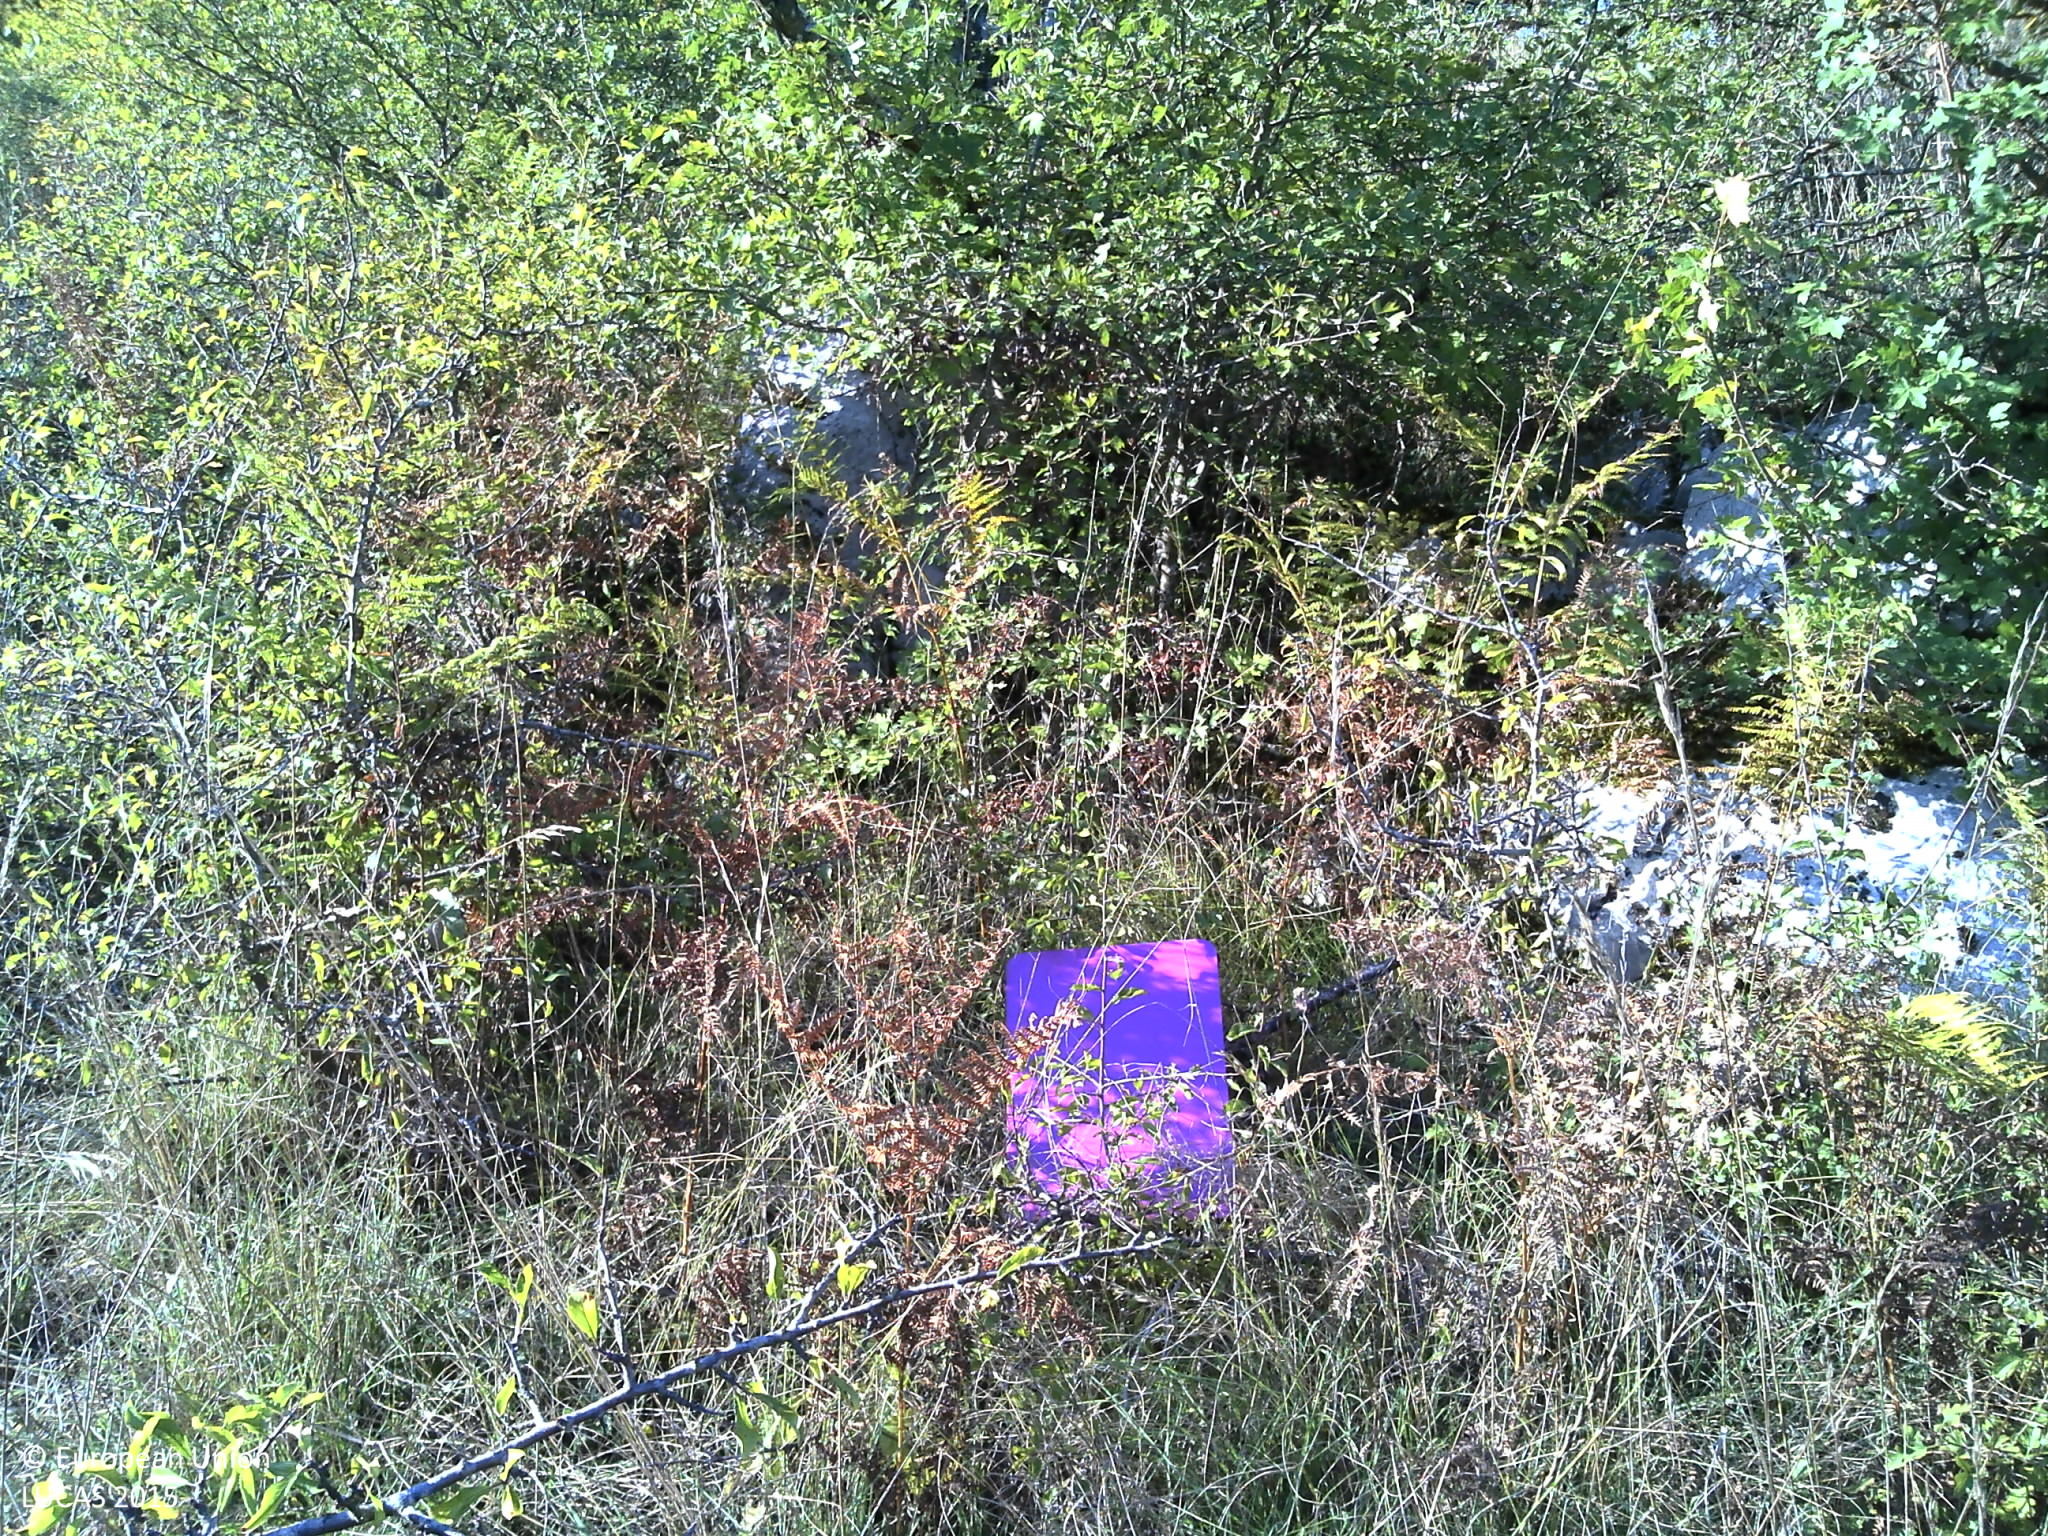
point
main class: Shrubland
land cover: Shrubland with sparse tree cover
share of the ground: > 75 %
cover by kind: shrubs 75 %, herbaceous plants 20 %, broadleaved forest trees 5 %
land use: Semi-natural and natural areas not in use
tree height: < 5 m
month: August
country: HR
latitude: 45.1095
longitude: 15.1169
